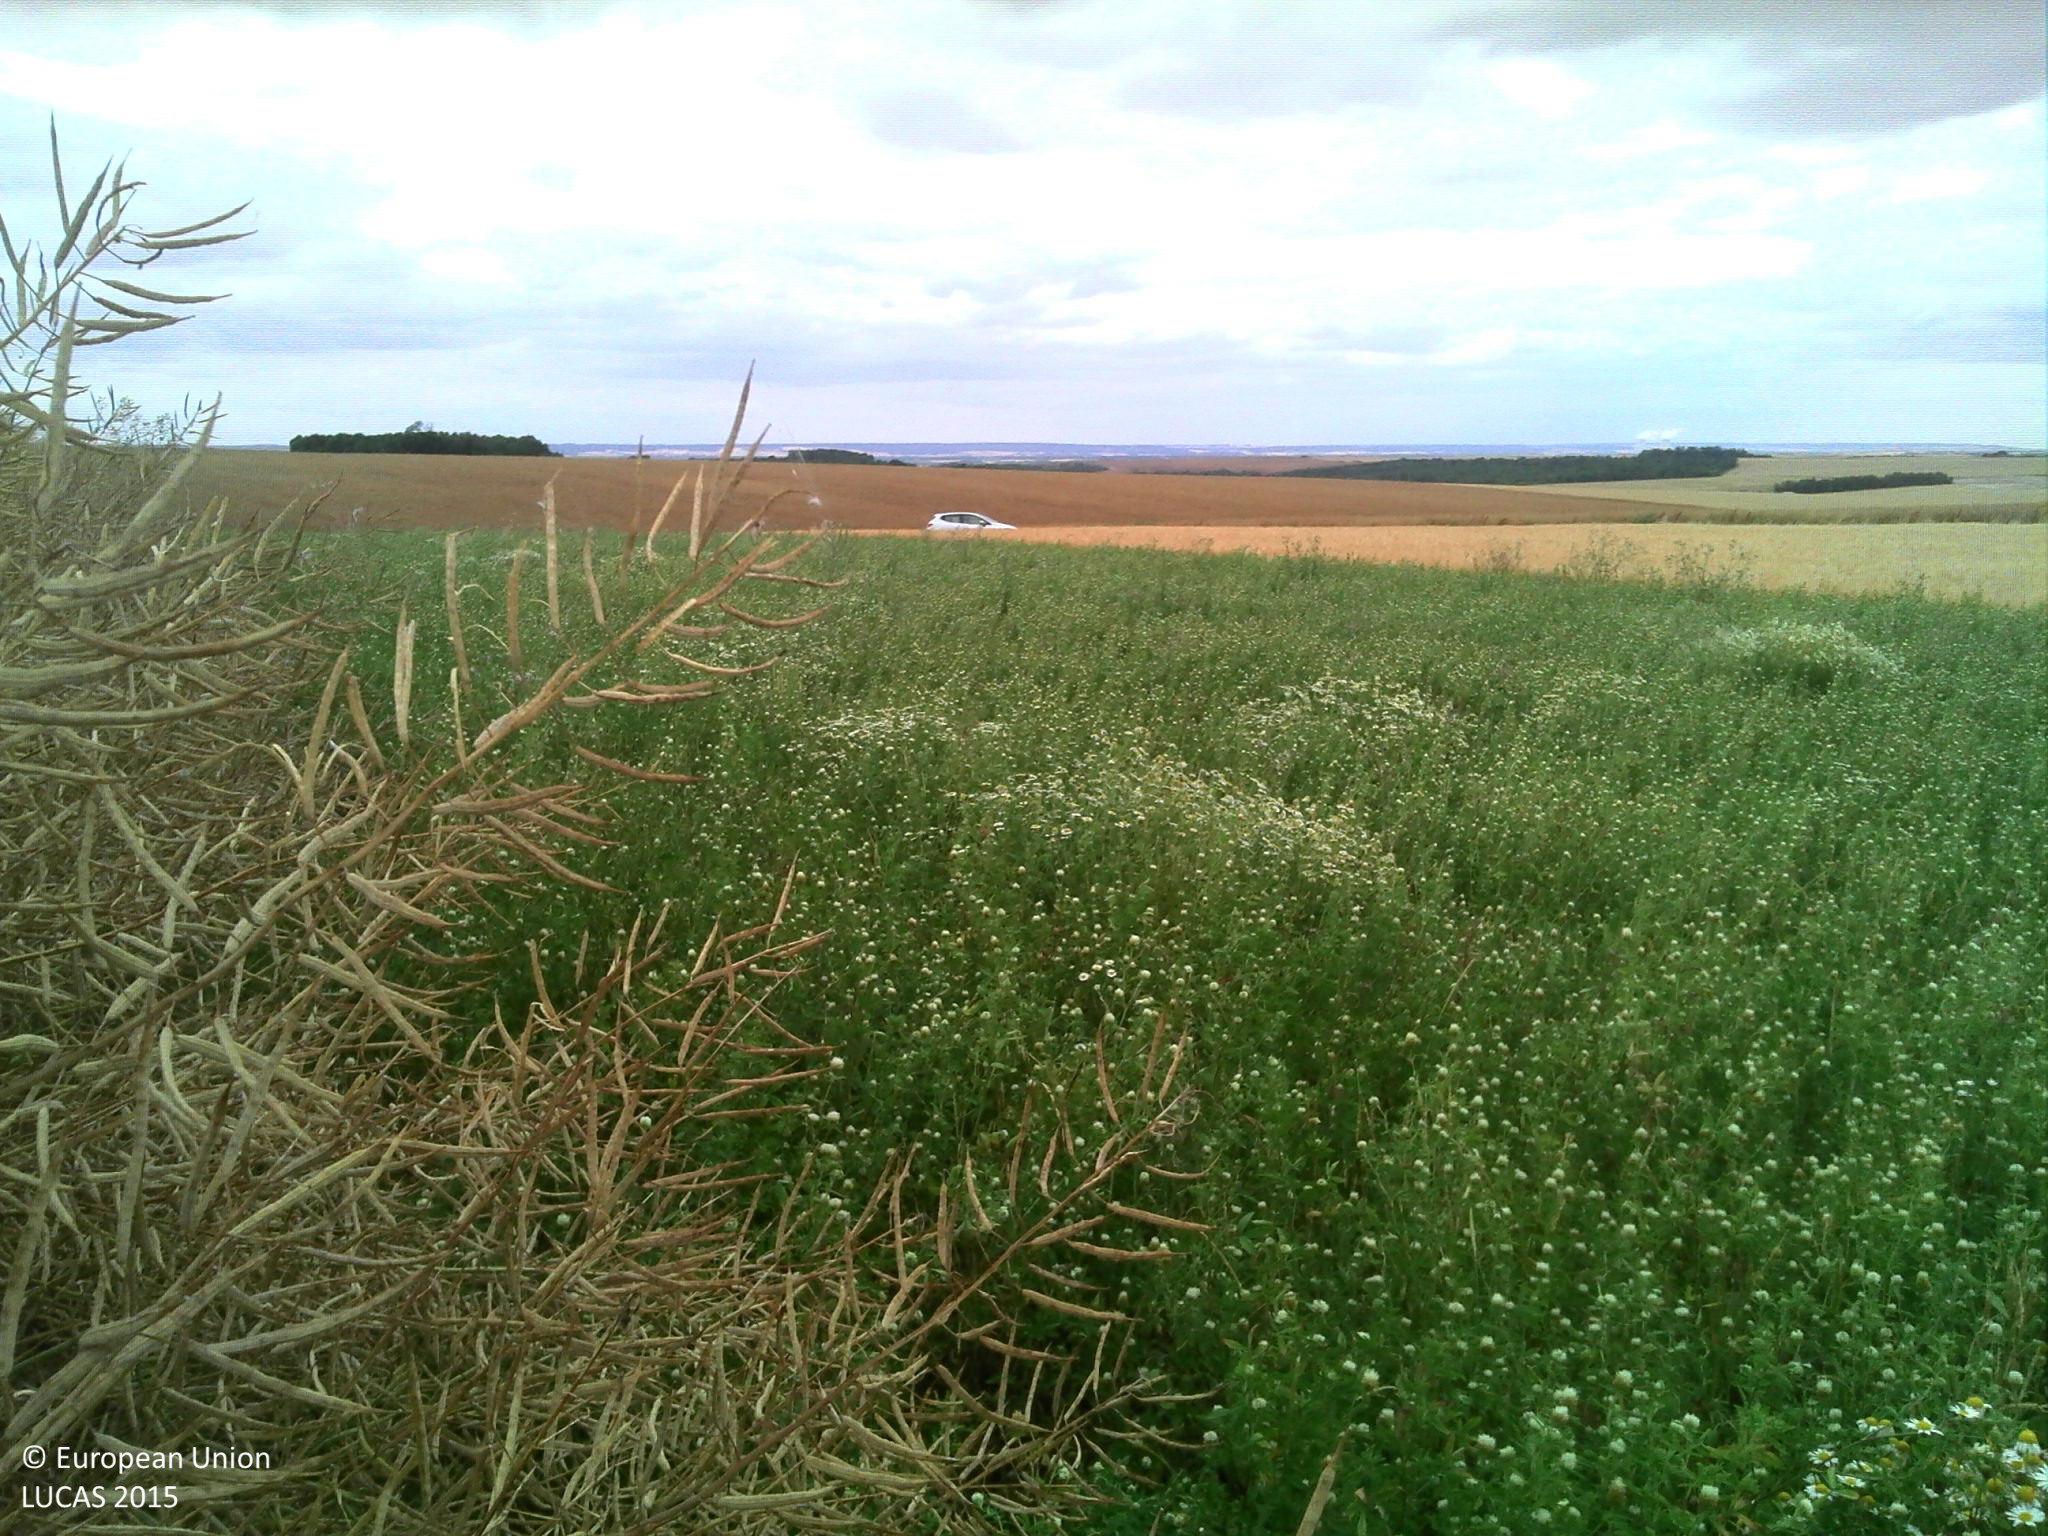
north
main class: Cropland
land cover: Rape and turnip rape
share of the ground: > 75 %
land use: Agriculture (excluding fallow land and kitchen gardens)
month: July
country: FR
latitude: 48.3504
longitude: 3.3952
